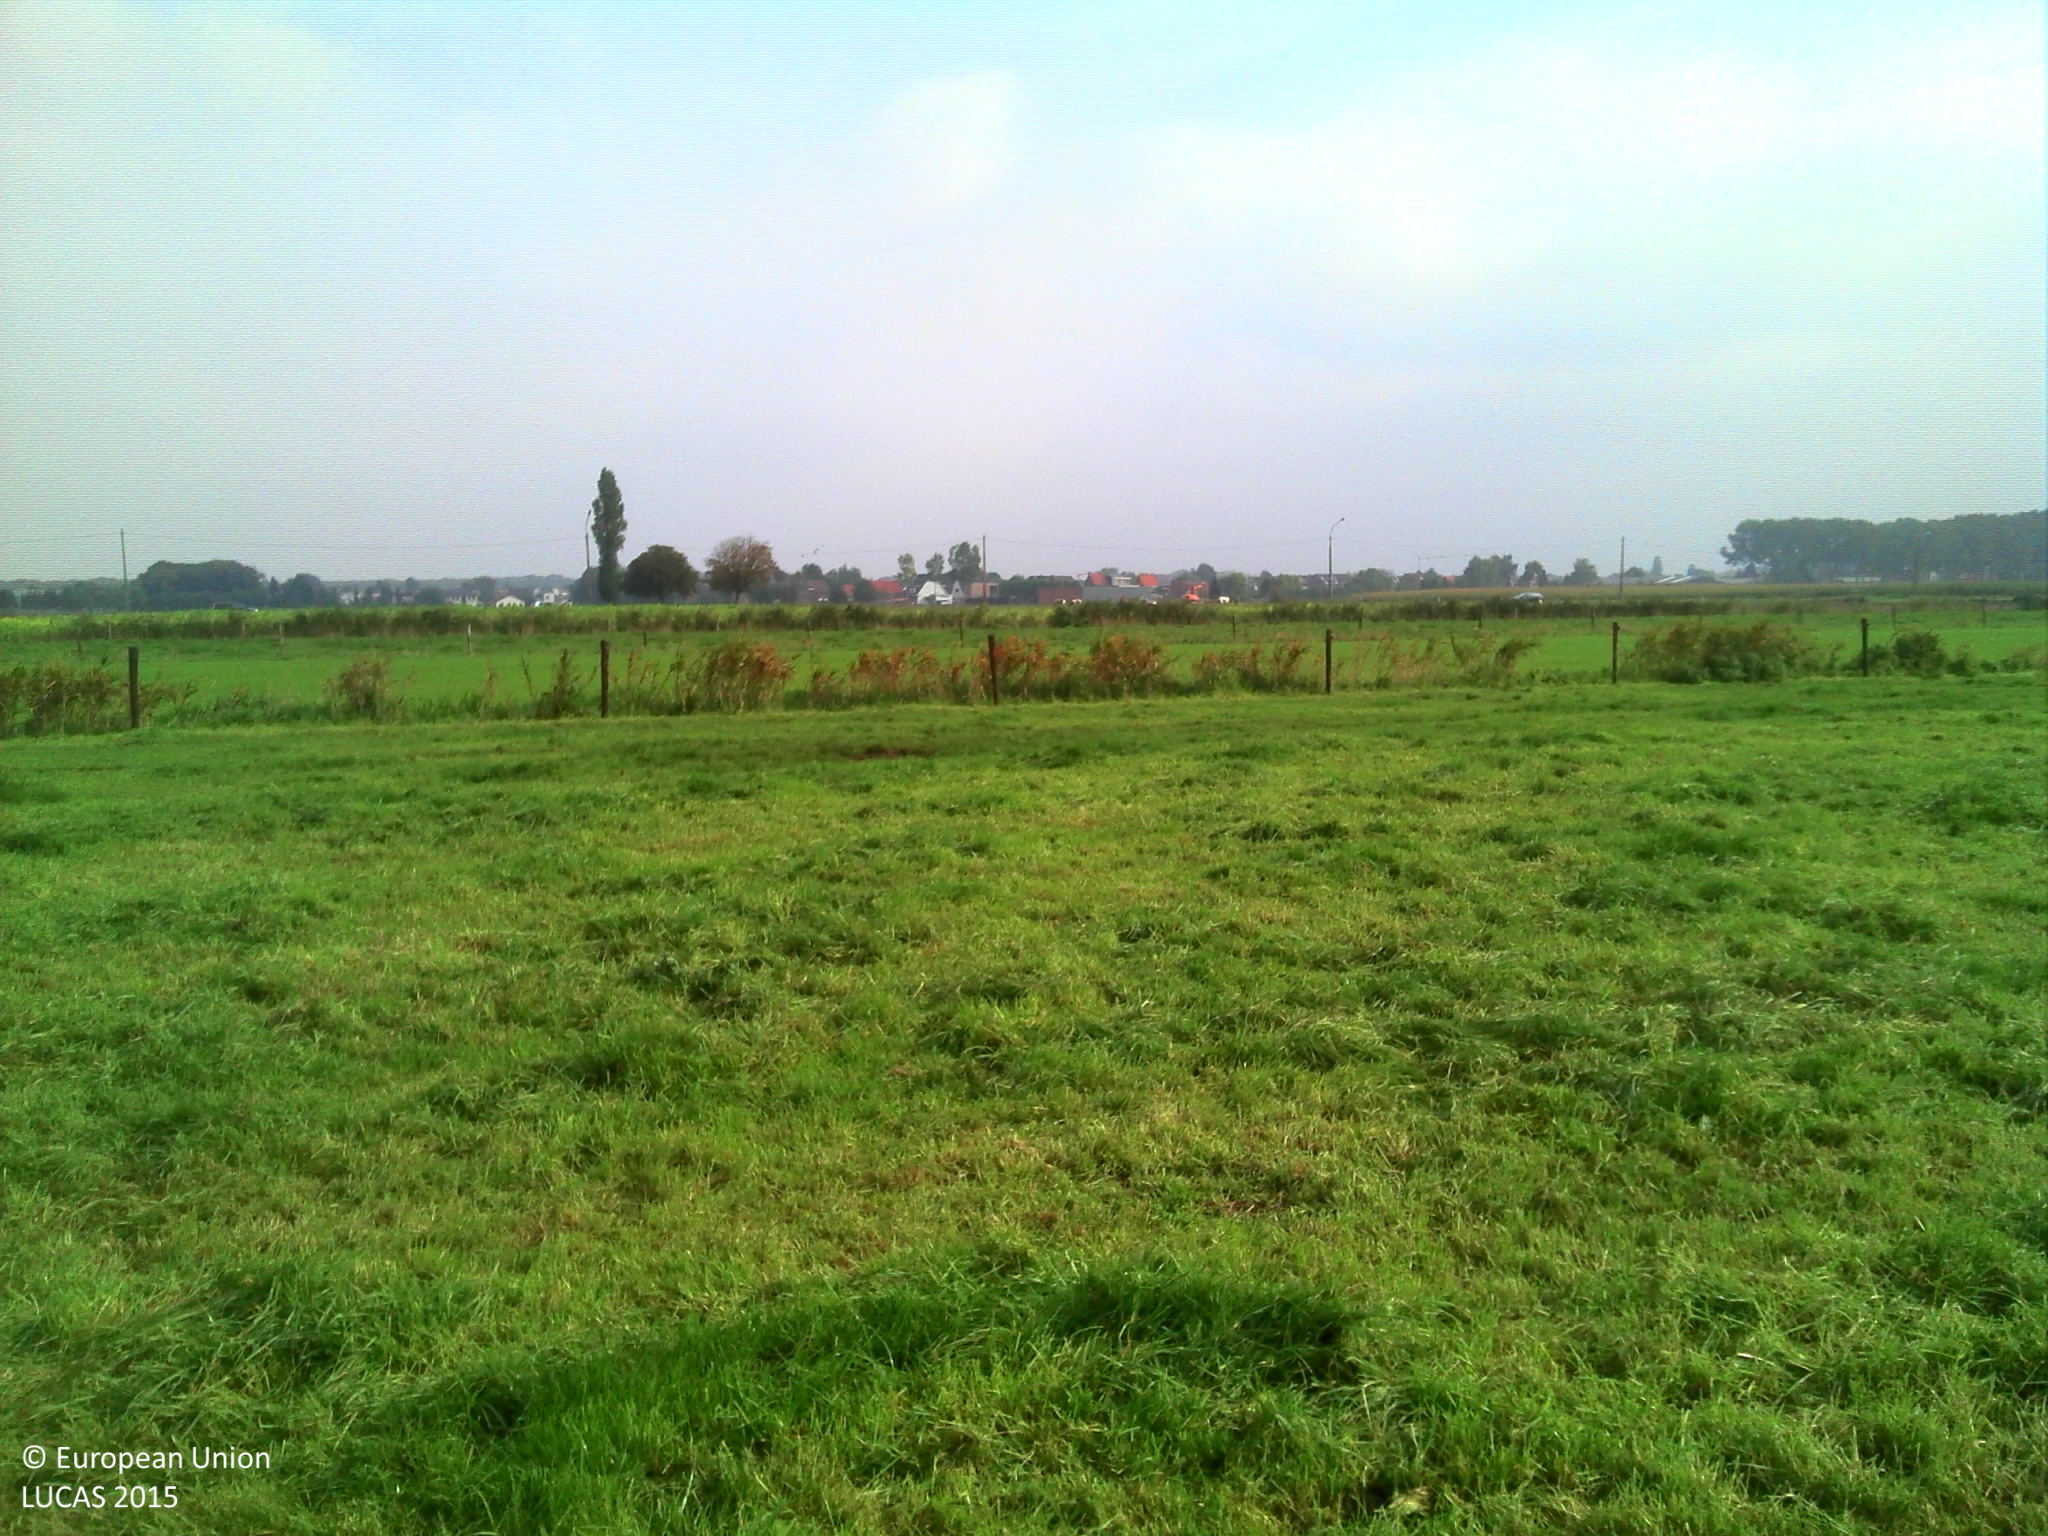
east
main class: Grassland
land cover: Grassland without tree/shrub cover
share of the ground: > 75 %
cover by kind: herbaceous plants 100 %
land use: Agriculture (excluding fallow land and kitchen gardens)
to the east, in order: Grassland without tree/shrub cover; Fences; Grass margins; Ditches and canals; Temporary grasslands; Ditches and canals; Grass margins; Fences; Grassland without tree/shrub cover; Fences; Grass margins; Ditches and canals; Grass margins; Other fibre and oleaginous crops; Grass margins; Ditches and canals; Grass margins; Other root crops; Grass margins; Ditches and canals; Grass margins; Paved roads, cycling and walking lanes; Grass margins; Ditches and canals; Grass margins; Electric lines; Fences; Grassland without tree/shrub cover
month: October
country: BE
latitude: 51.3077
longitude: 4.3865
